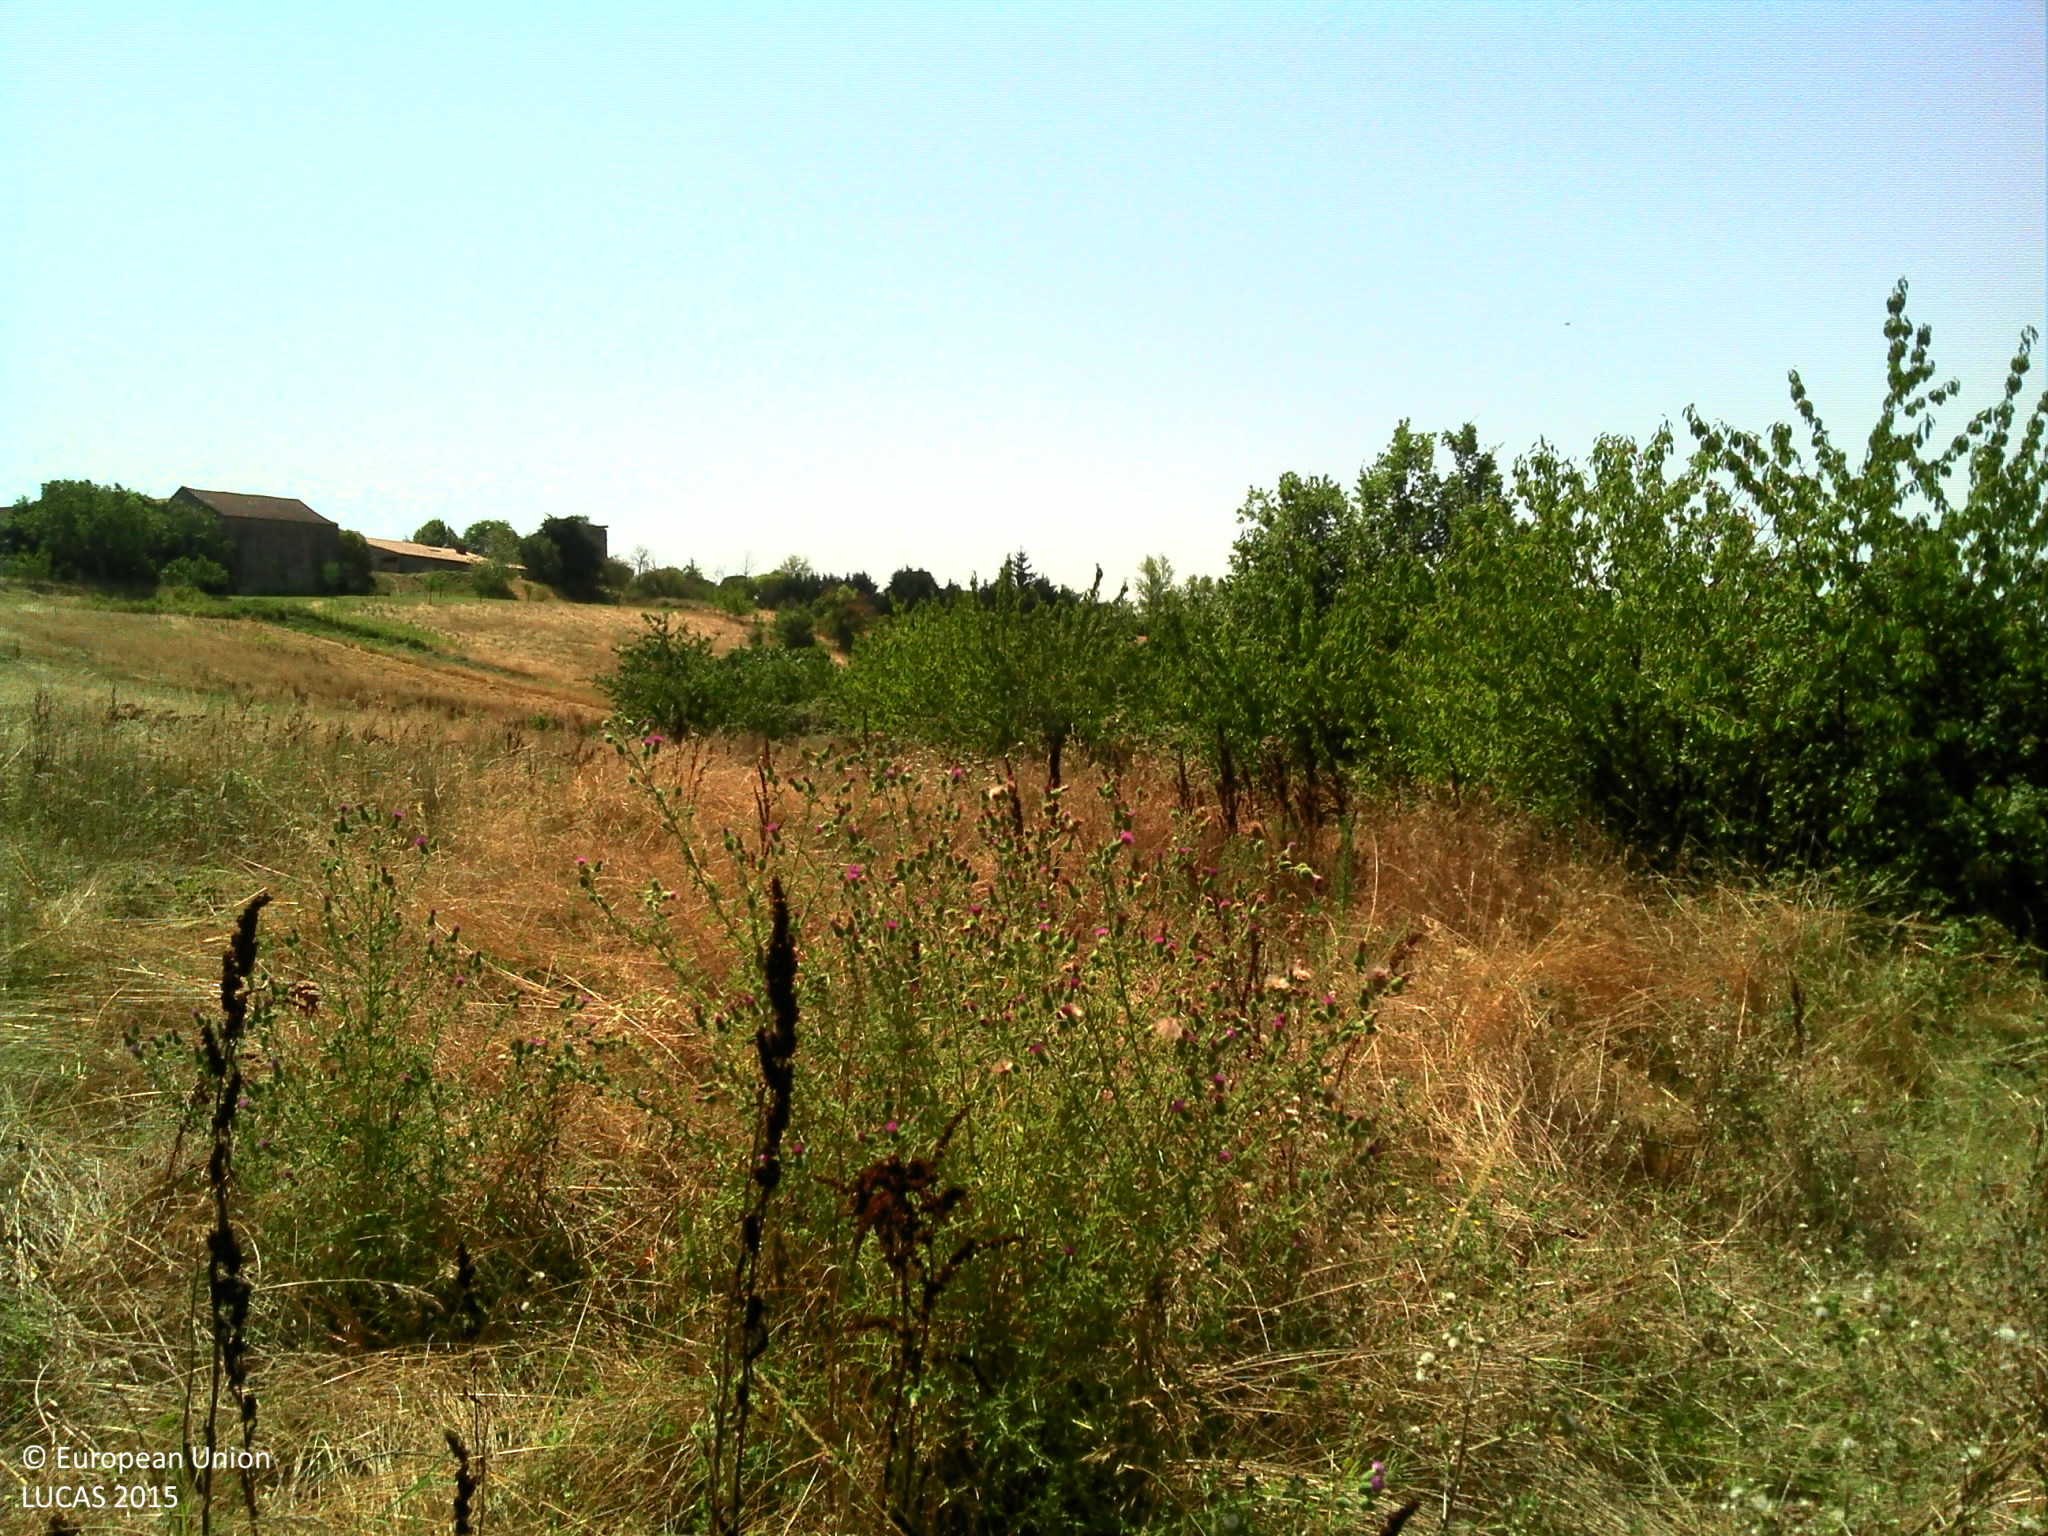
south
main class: Grassland
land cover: Spontaneously vegetated surfaces
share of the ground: > 75 %
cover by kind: herbaceous plants 100 %
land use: Fallow land
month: August
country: FR
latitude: 44.1414
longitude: 0.6070
